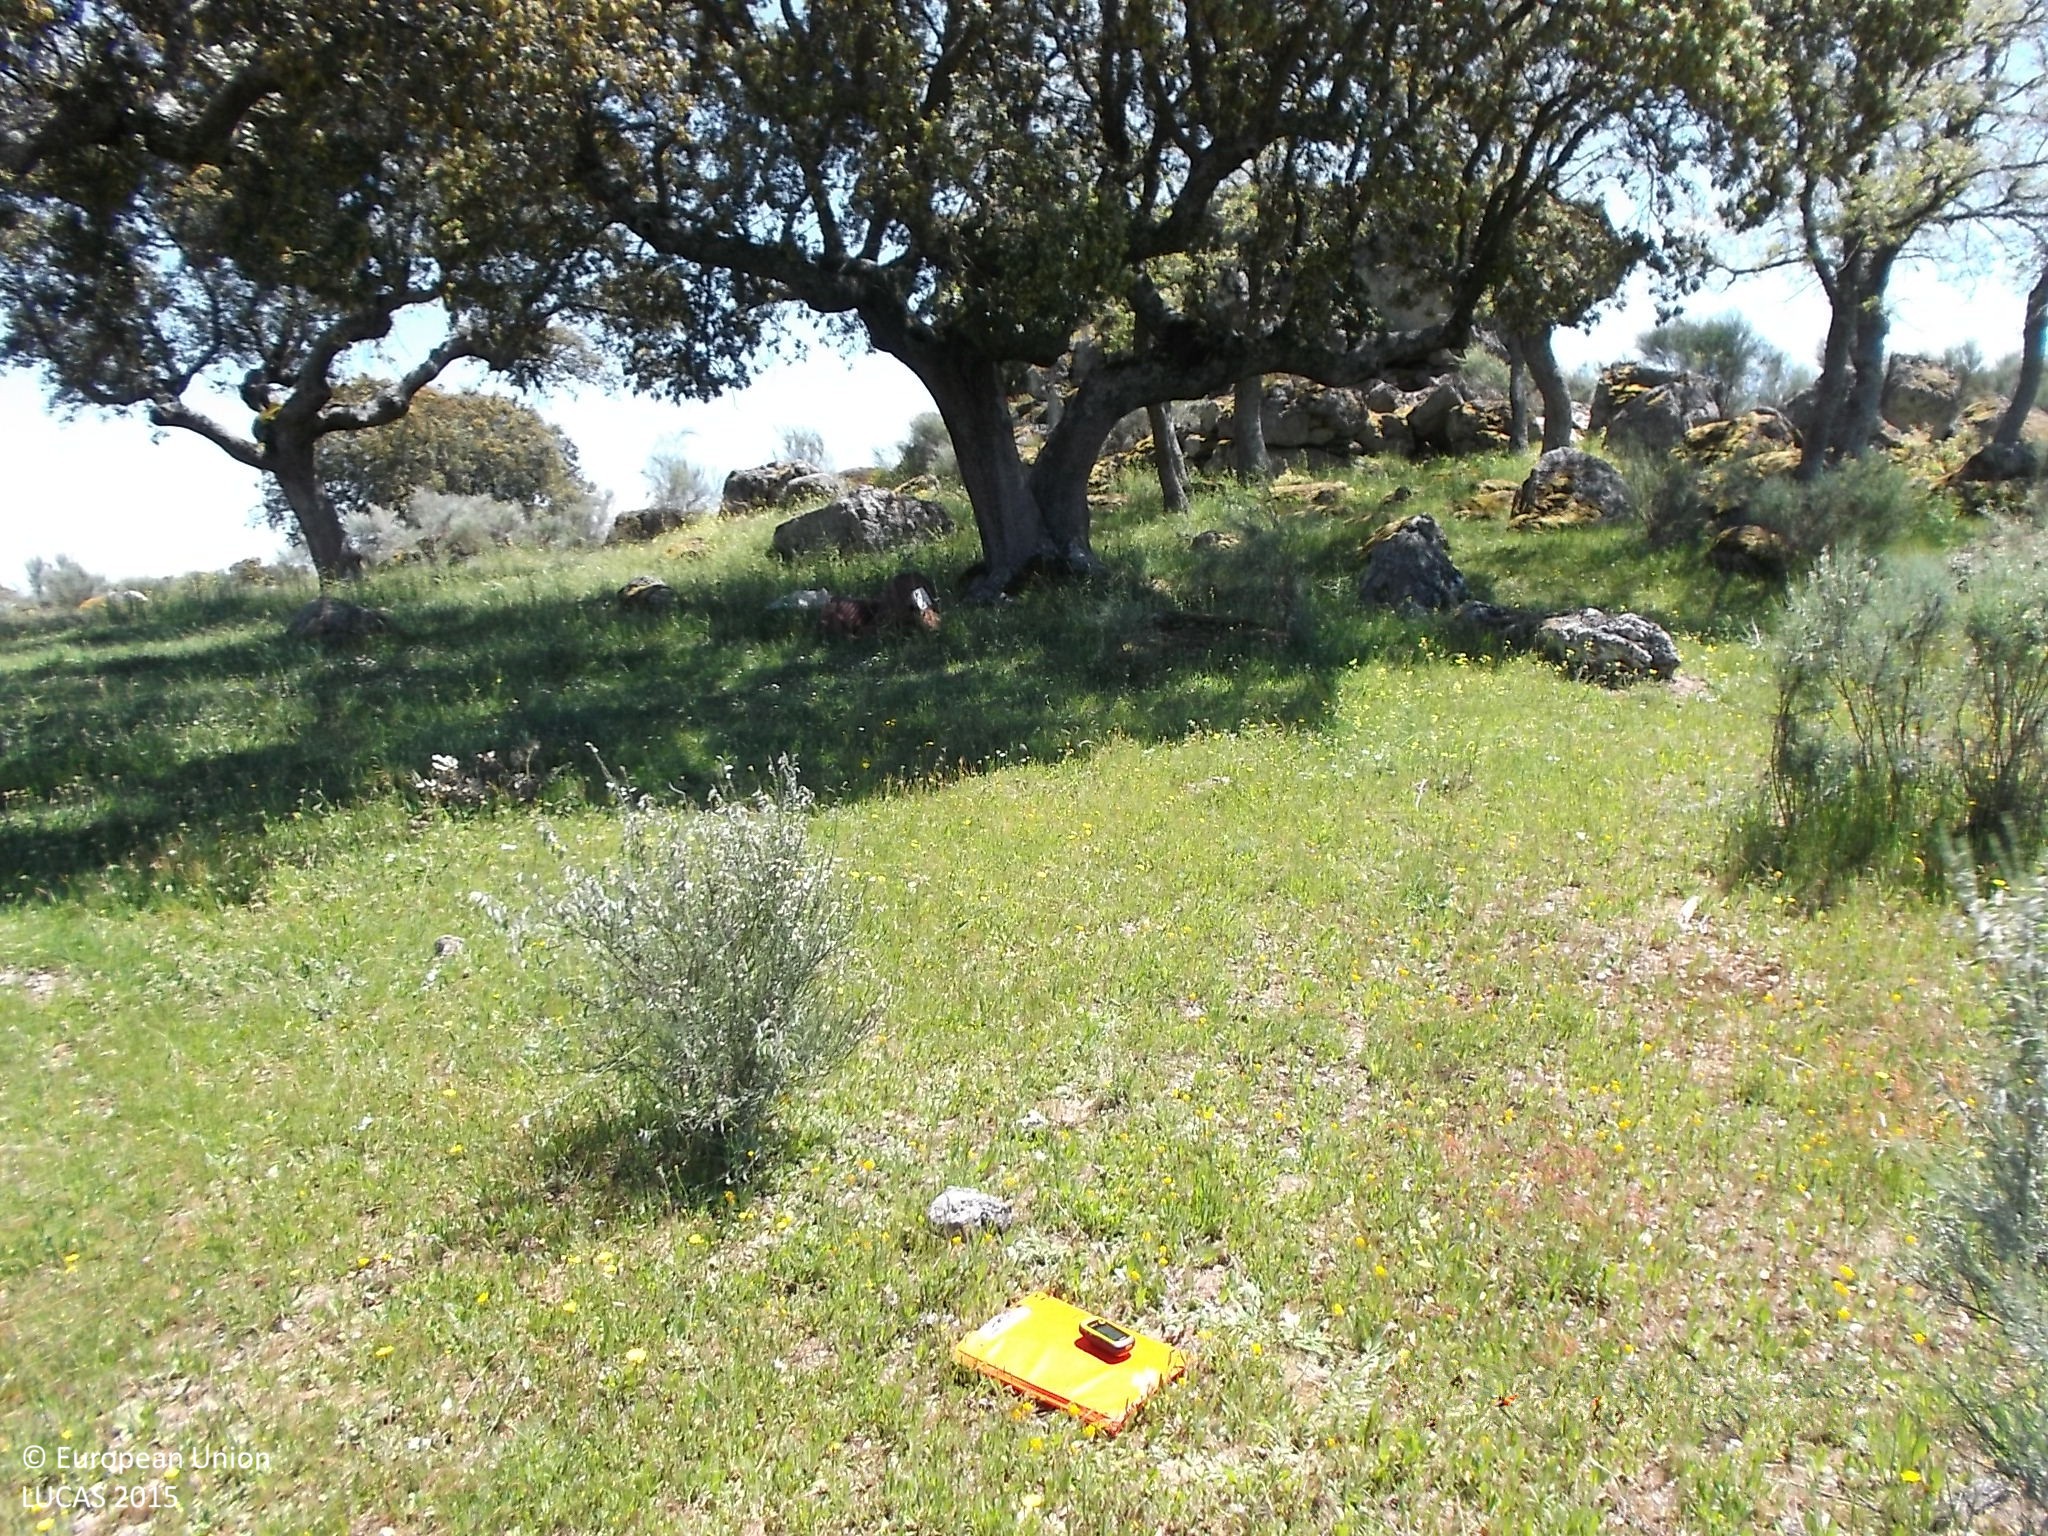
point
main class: Woodland
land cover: Broadleaved woodland
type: broadleaved evergreen forest
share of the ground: 10 - 25 %
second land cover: Grassland without tree/shrub cover
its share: > 75 %
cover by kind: herbaceous plants 70 %, broadleaved forest trees 20 %, shrubs 10 %
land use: Forestry
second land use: Agriculture (excluding fallow land and kitchen gardens)
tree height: > 5 m
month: May
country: ES
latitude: 40.9091
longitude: -6.2464
